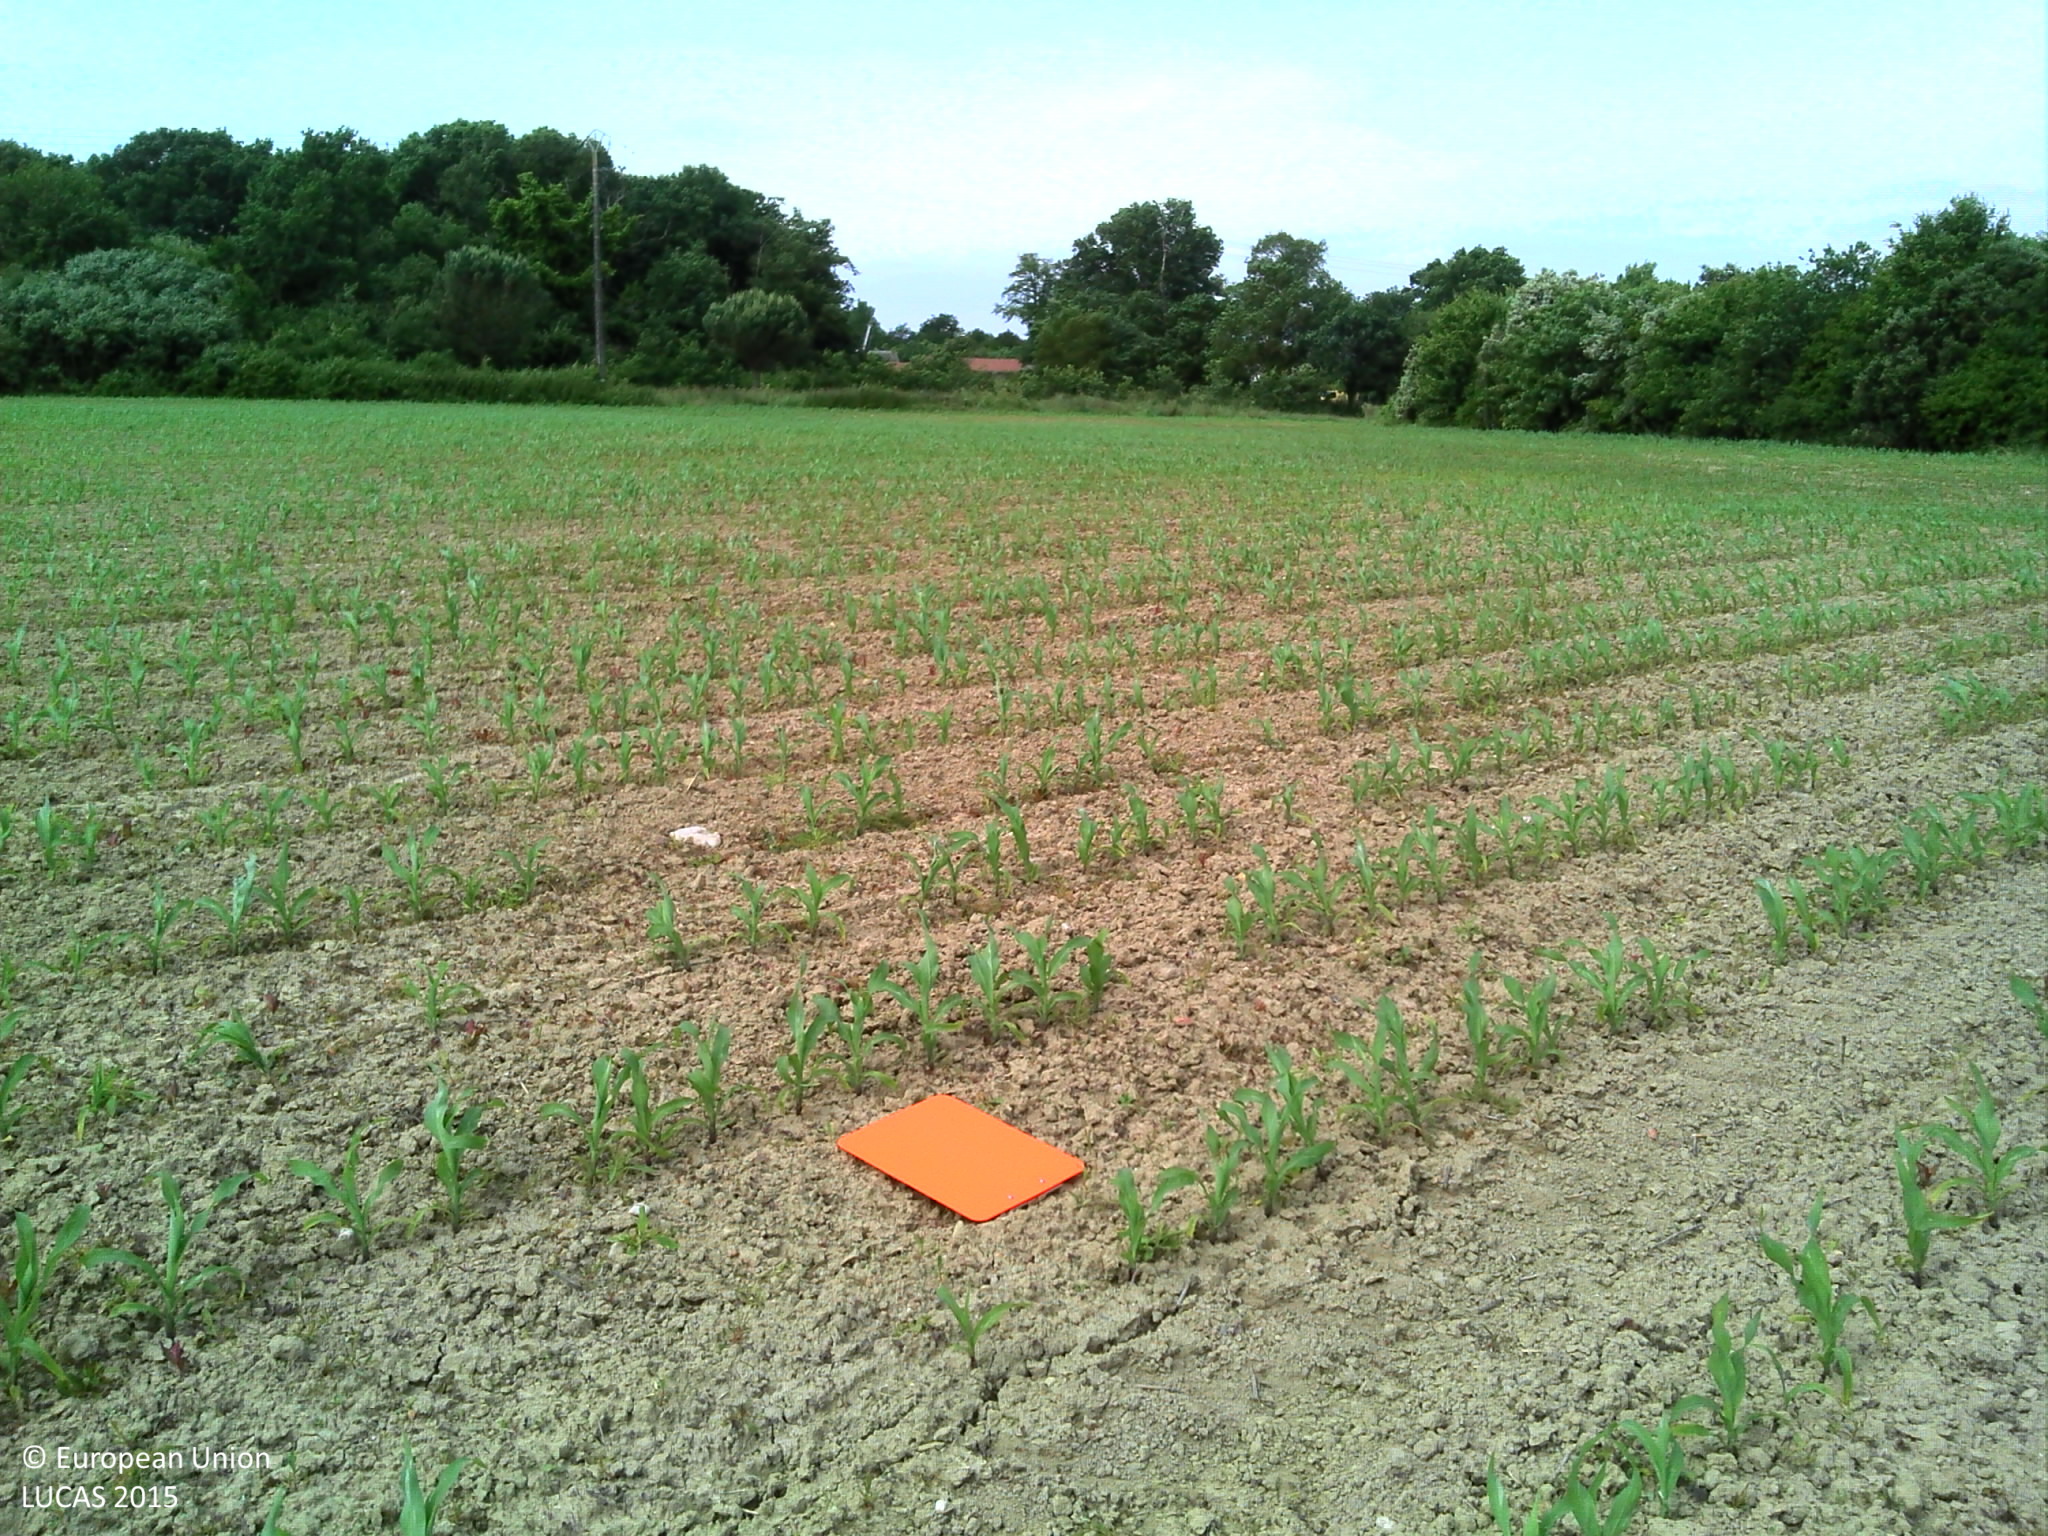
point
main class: Cropland
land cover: Maize
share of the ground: 10 - 25 %
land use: Agriculture (excluding fallow land and kitchen gardens)
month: June
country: FR
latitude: 47.1047
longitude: -2.0524
